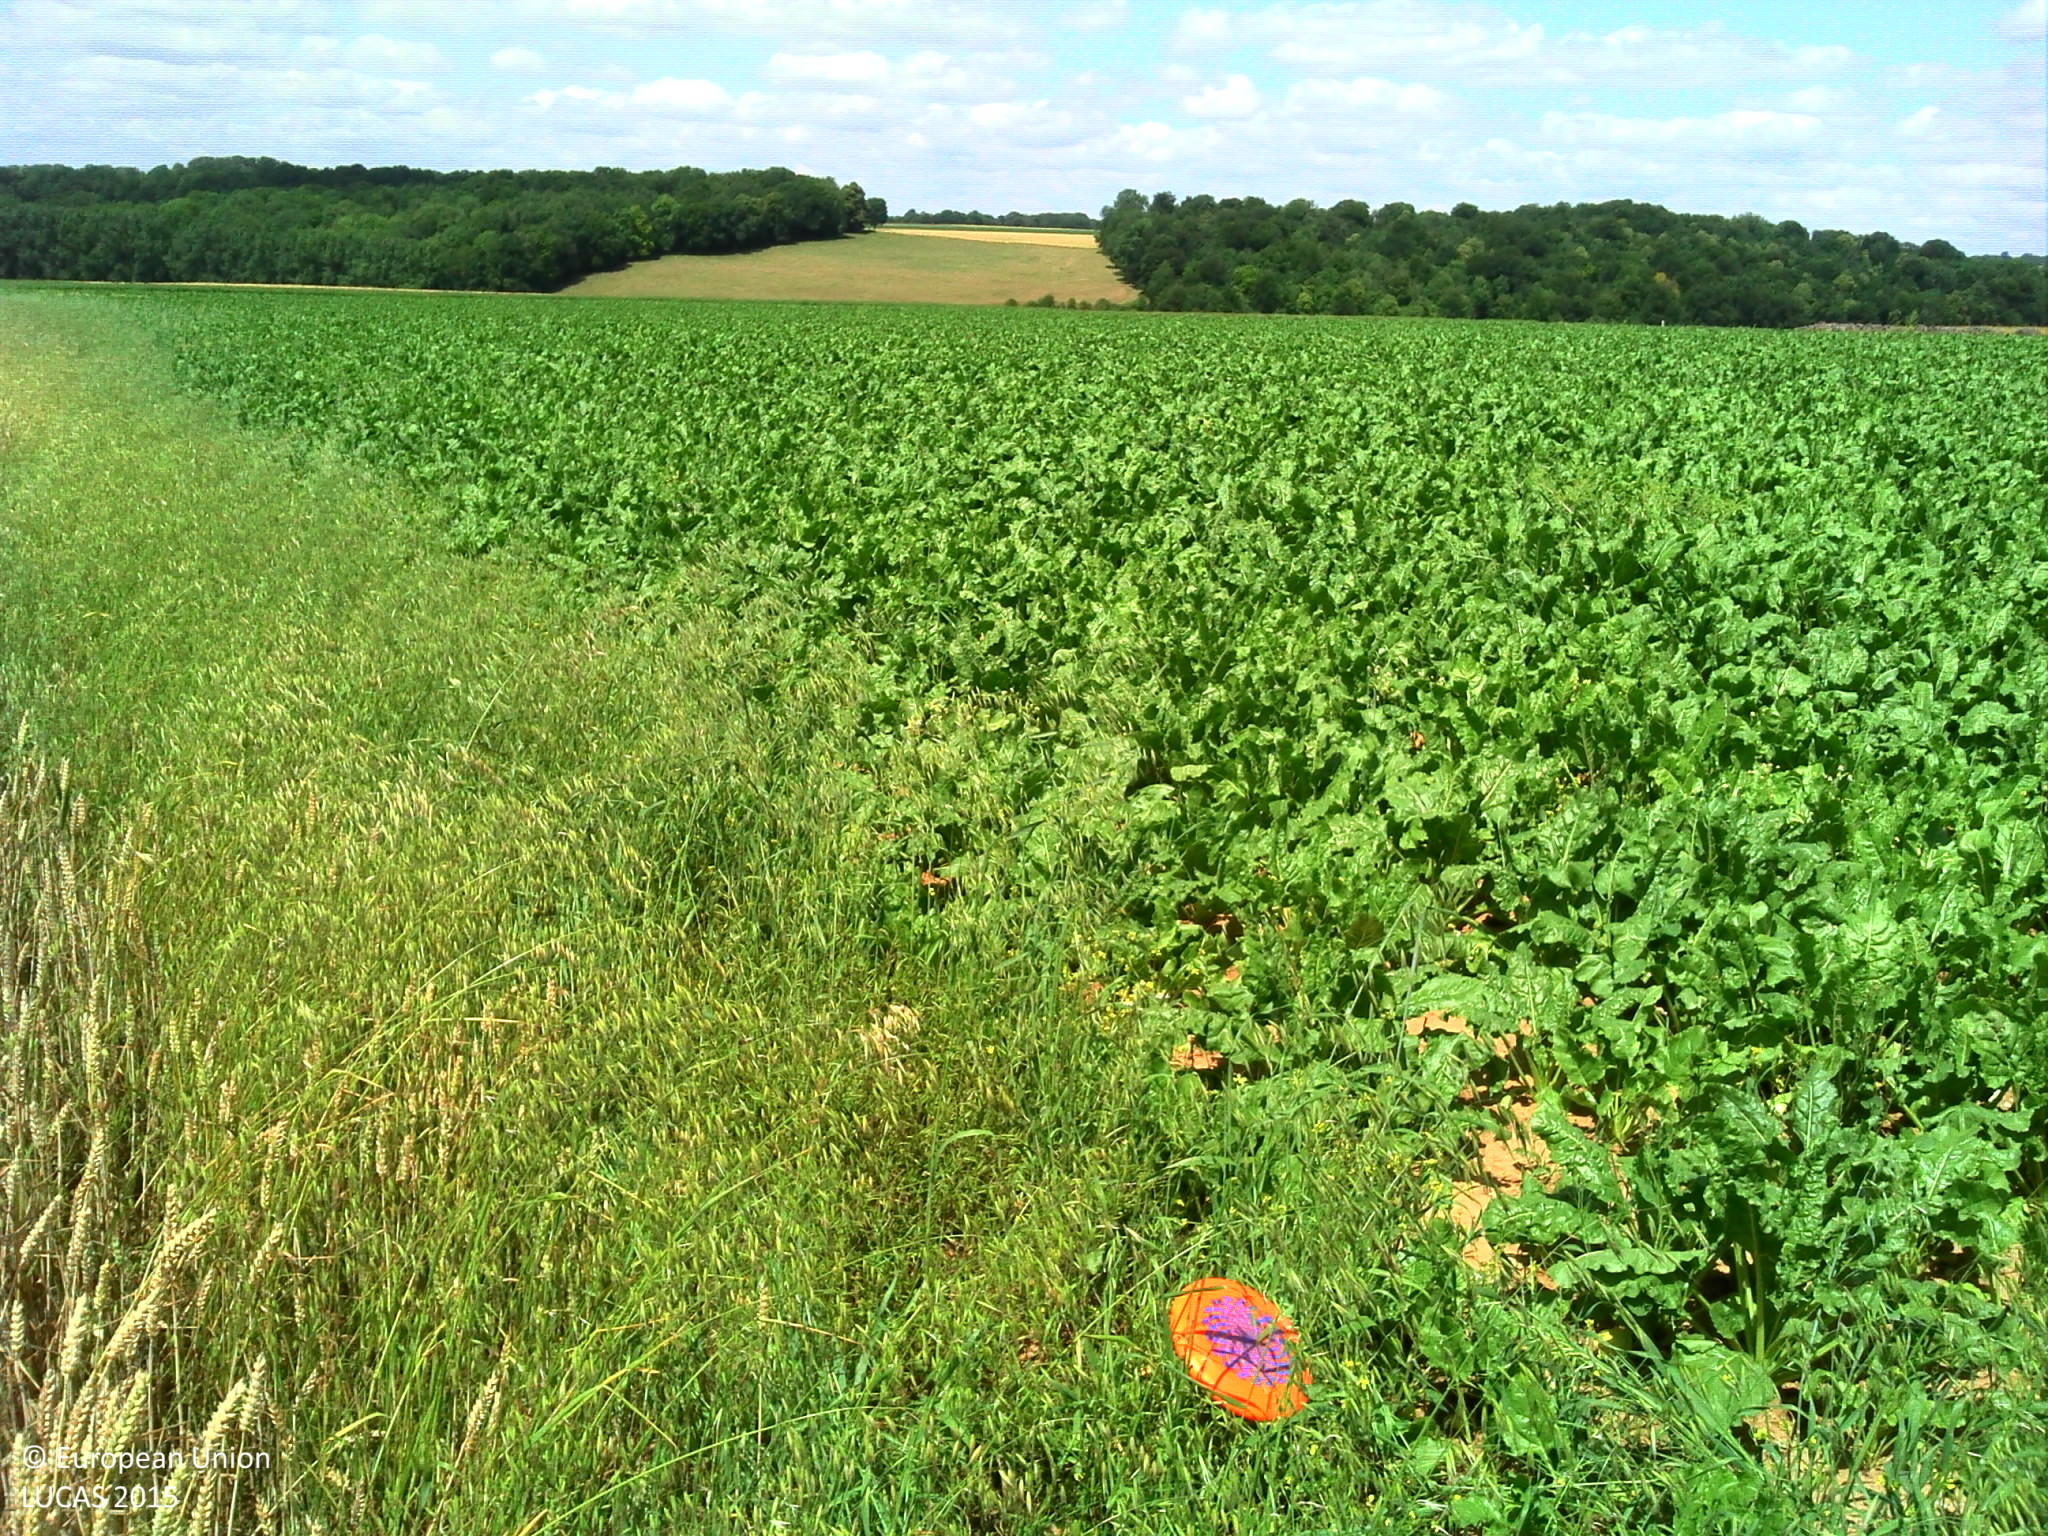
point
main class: Cropland
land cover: Sugar beet
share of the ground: > 75 %
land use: Agriculture (excluding fallow land and kitchen gardens)
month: July
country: FR
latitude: 50.3494
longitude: 2.1858
